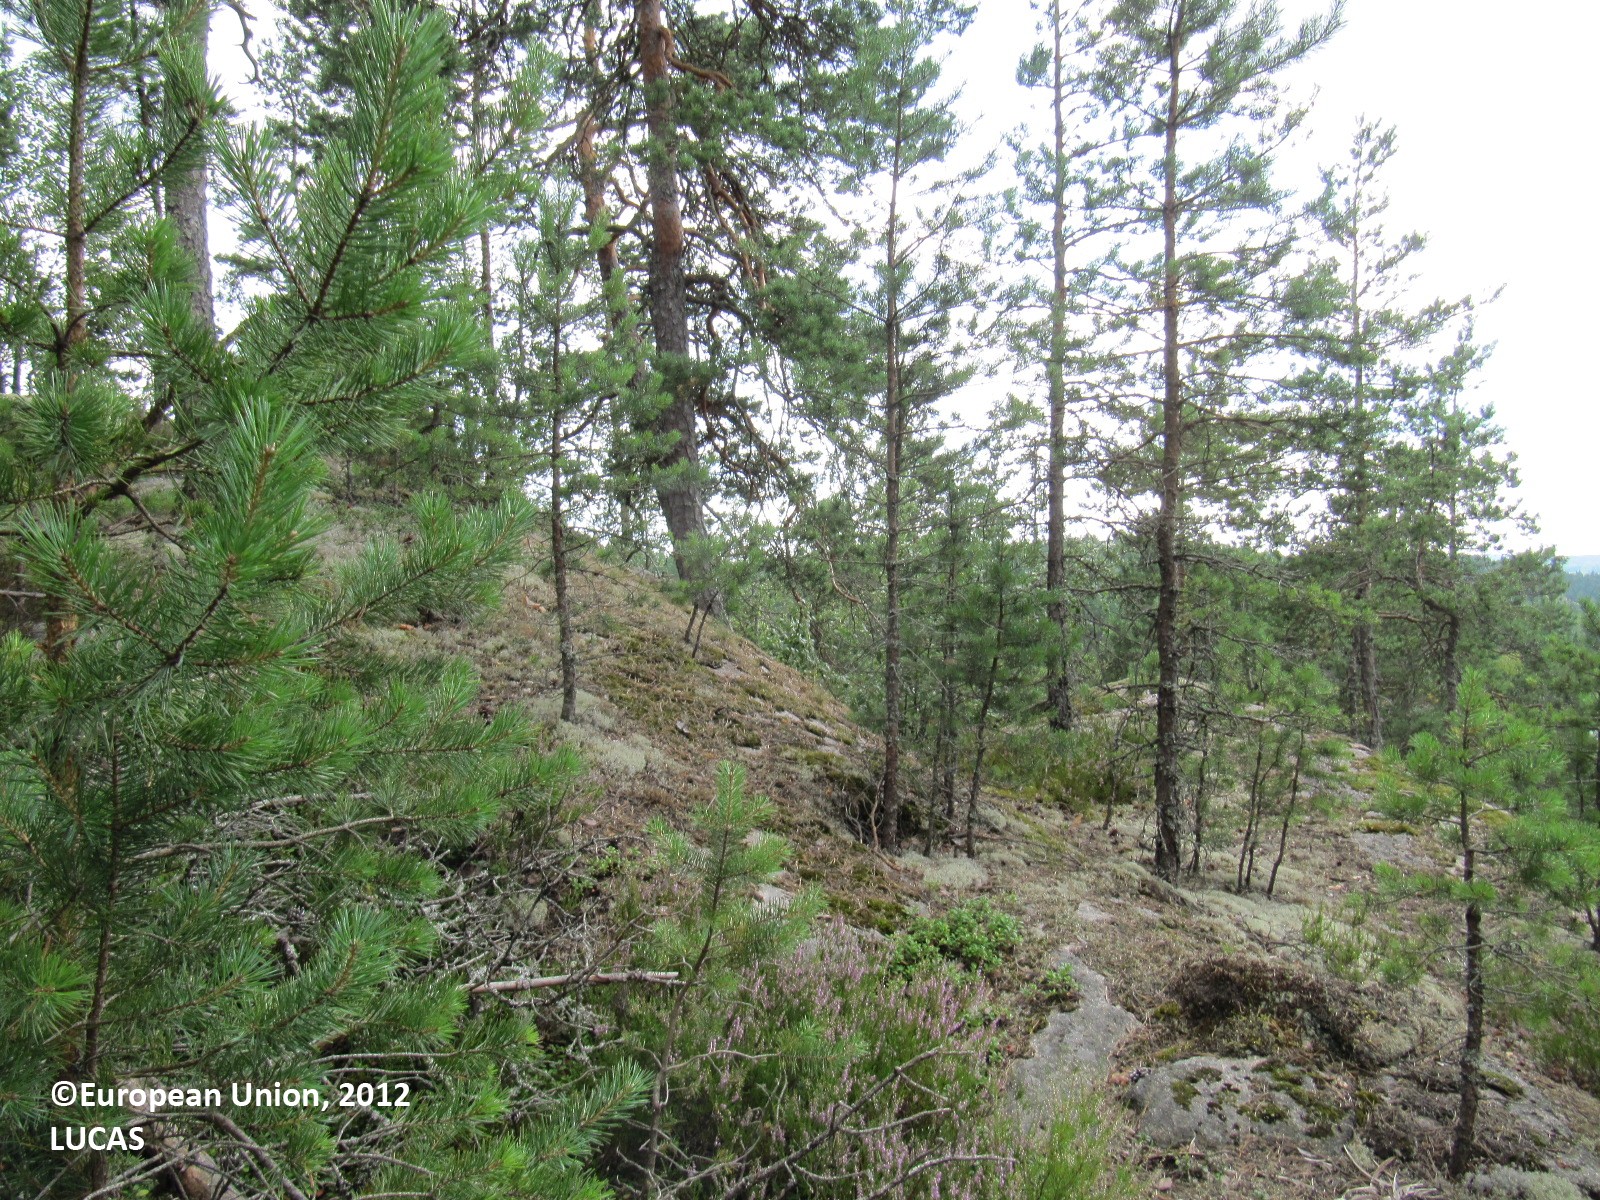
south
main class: Woodland
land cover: Pine dominated mixed woodland
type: boreal forest
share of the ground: 50 - 75 %
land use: Forestry
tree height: > 5 m
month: August
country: FI
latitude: 60.3802
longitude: 23.1964
